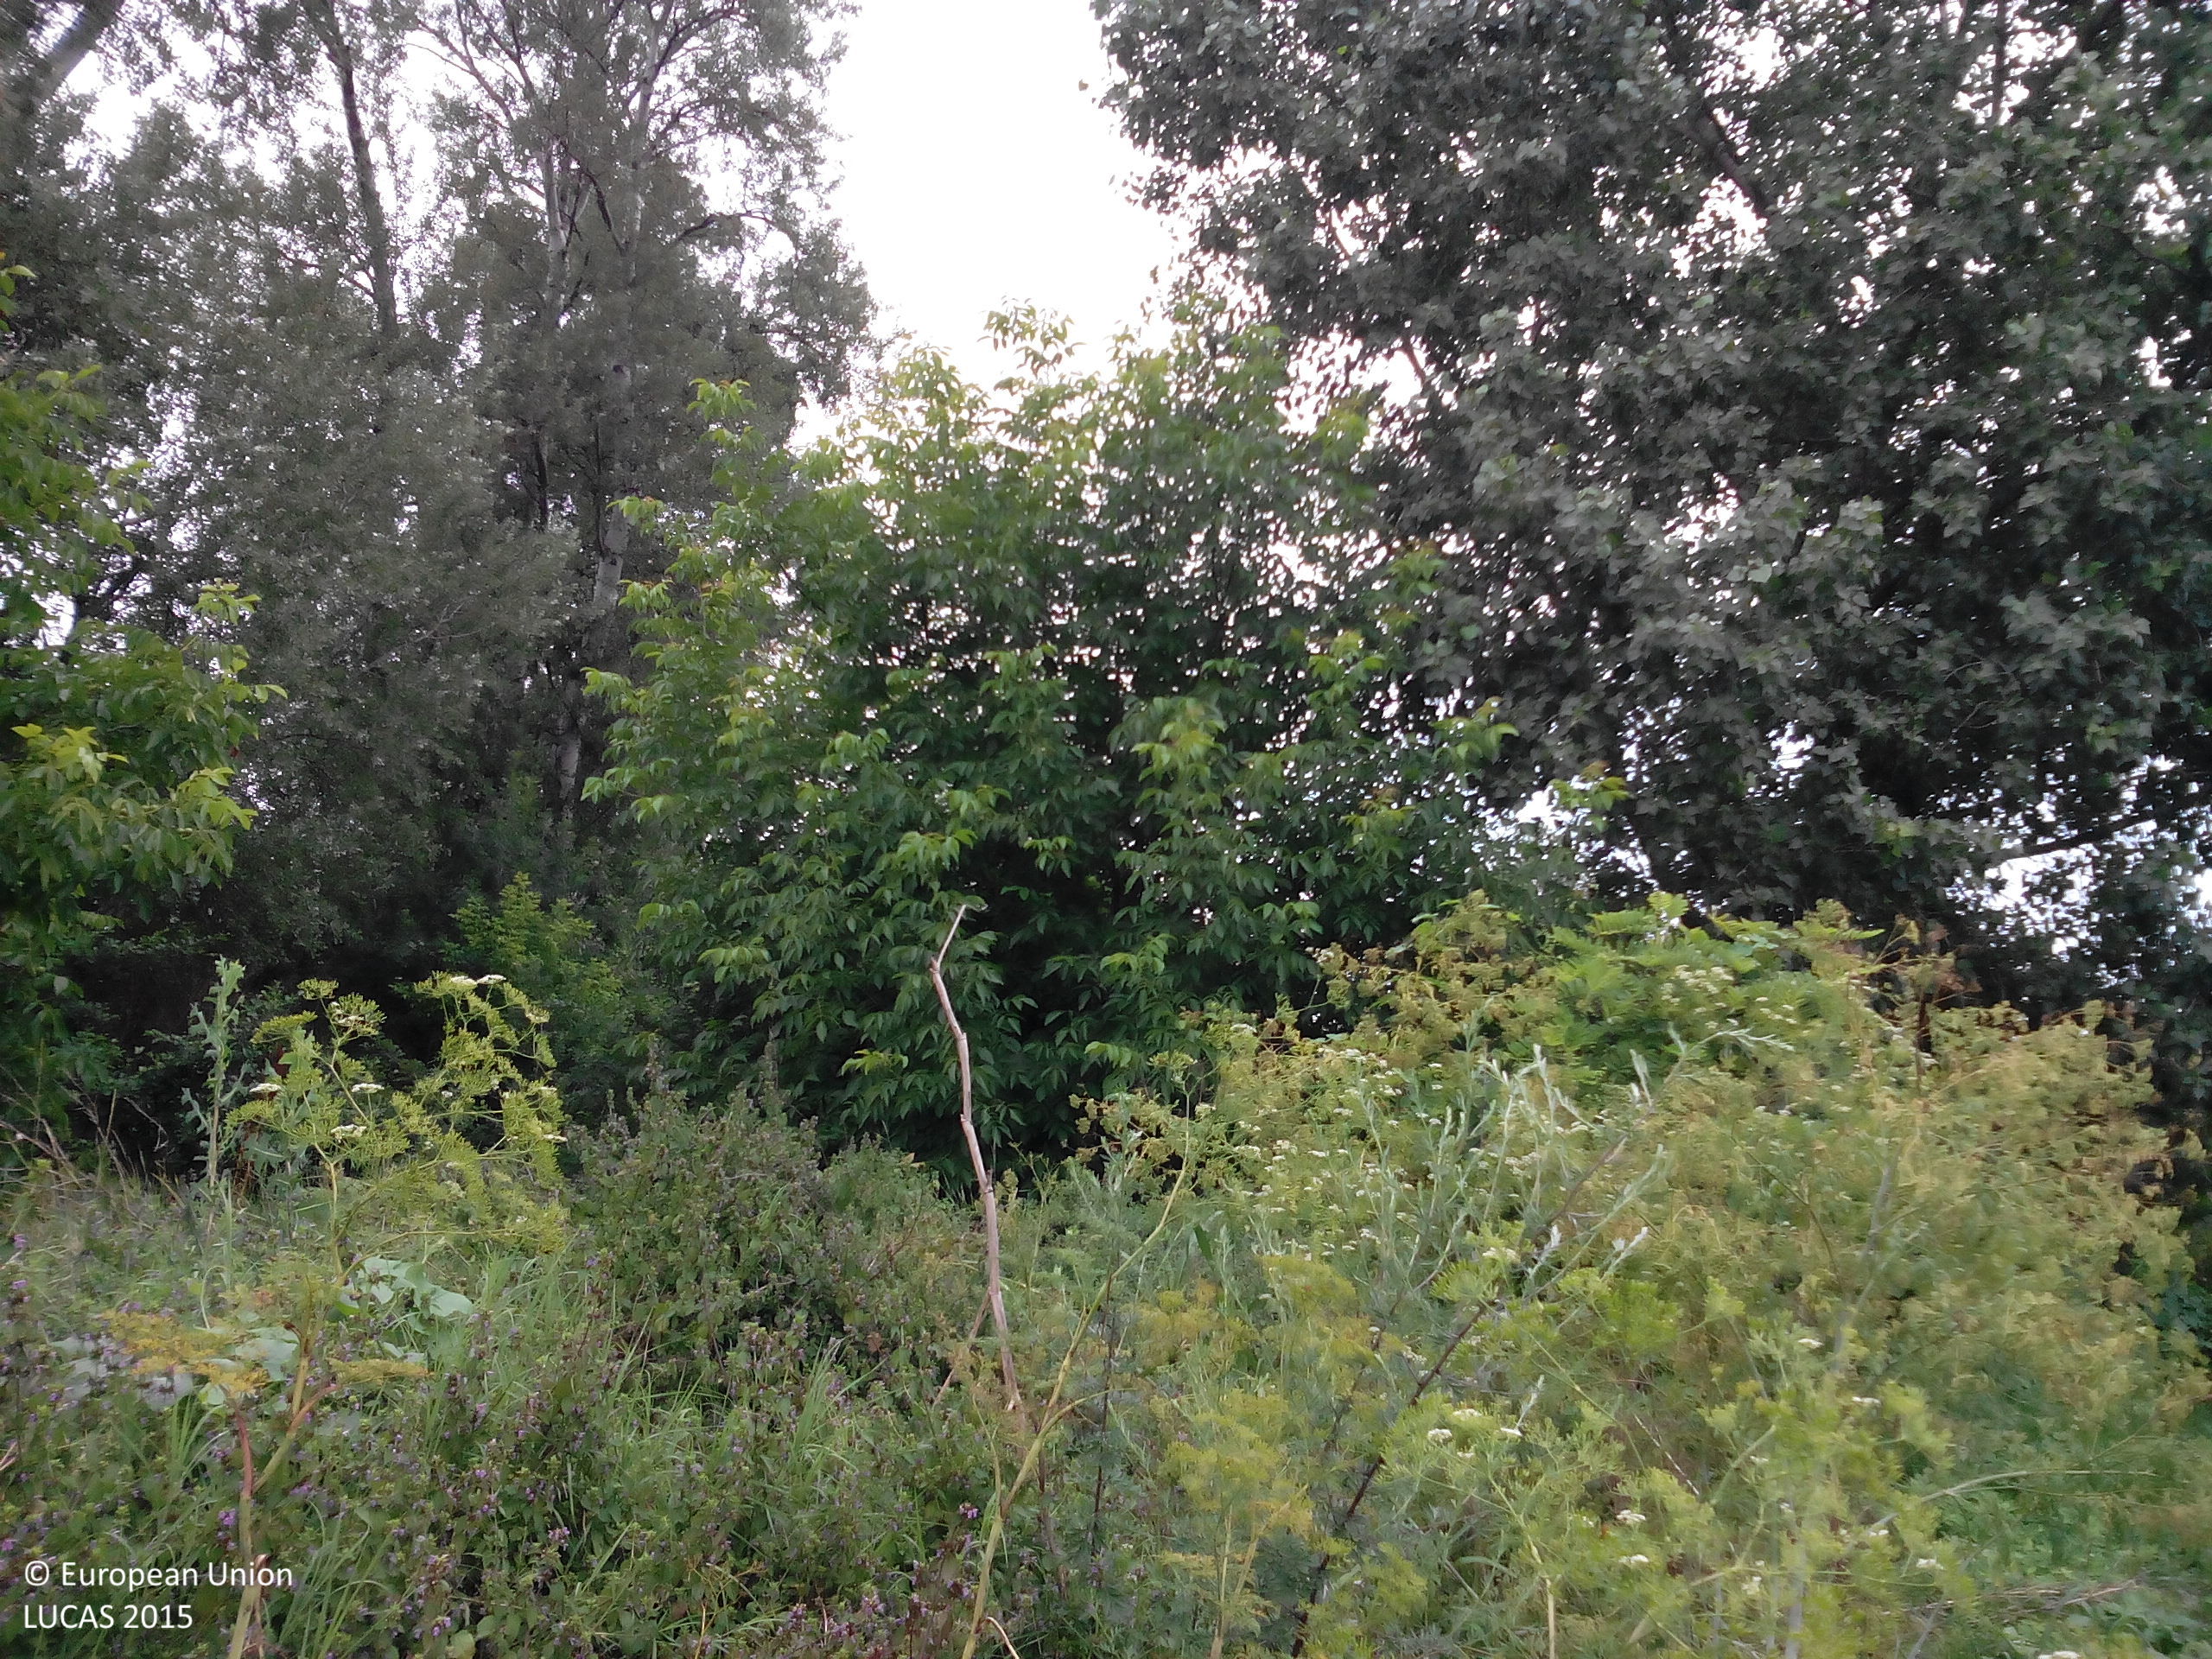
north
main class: Grassland
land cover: Spontaneously vegetated surfaces
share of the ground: > 75 %
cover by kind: herbaceous plants 95 %, shrubs 5 %
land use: Abandoned areas
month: July
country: BG
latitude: 43.4519
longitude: 24.2557
